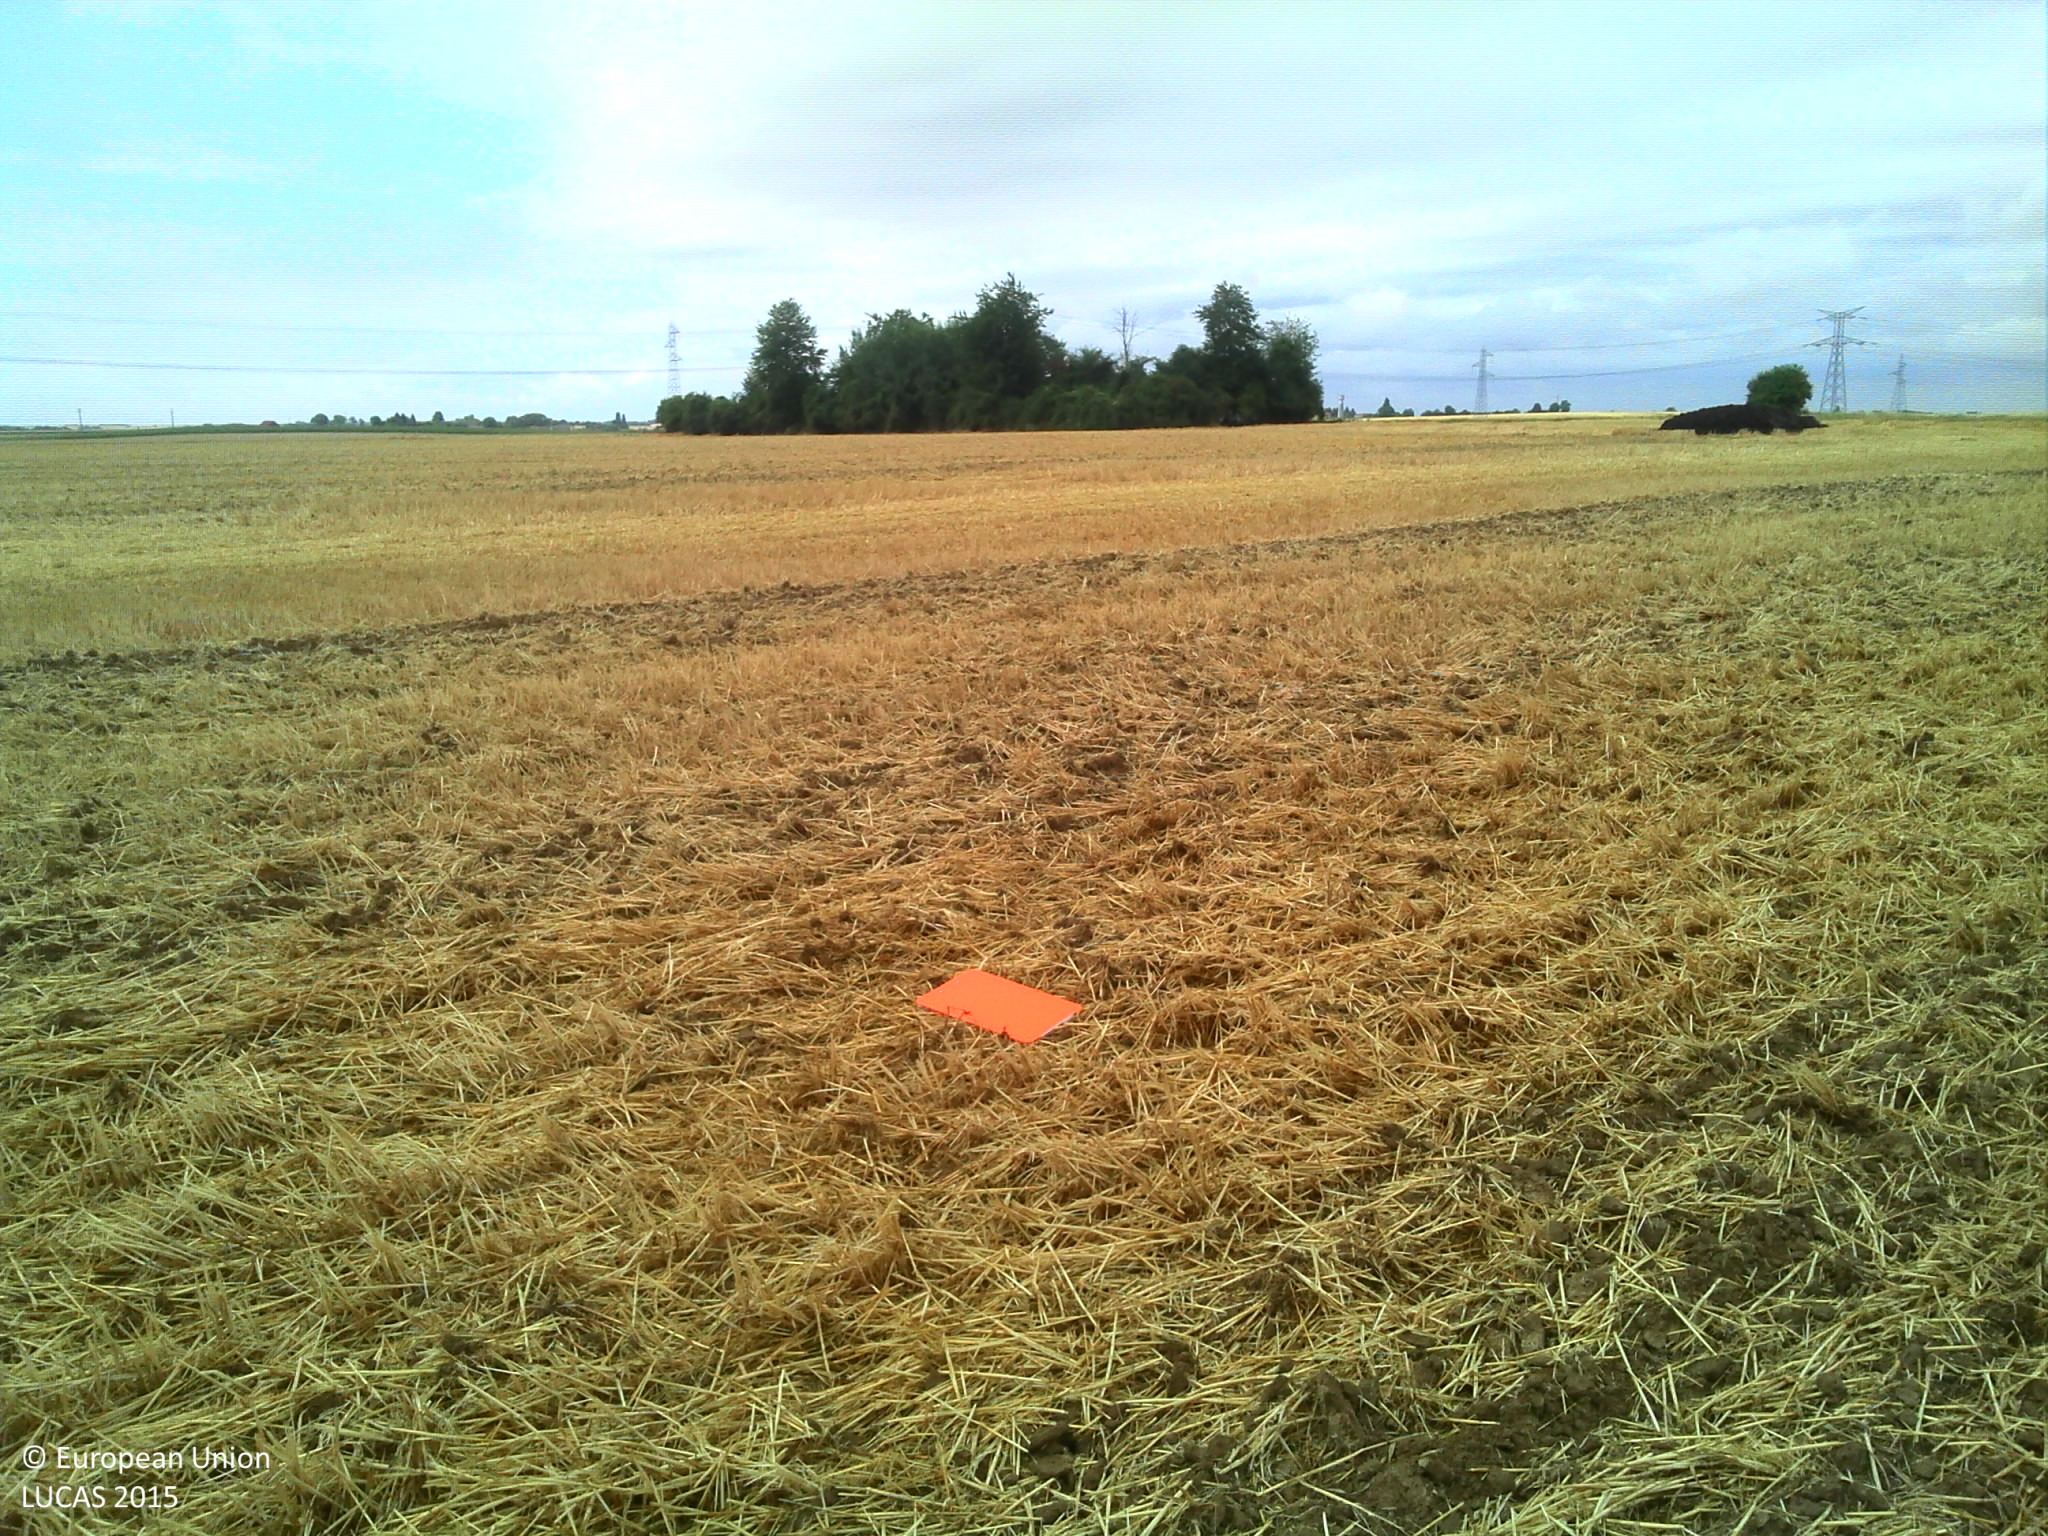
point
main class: Cropland
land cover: Common wheat
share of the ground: > 75 %
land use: Agriculture (excluding fallow land and kitchen gardens)
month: August
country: FR
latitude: 48.5832
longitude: 3.3645
